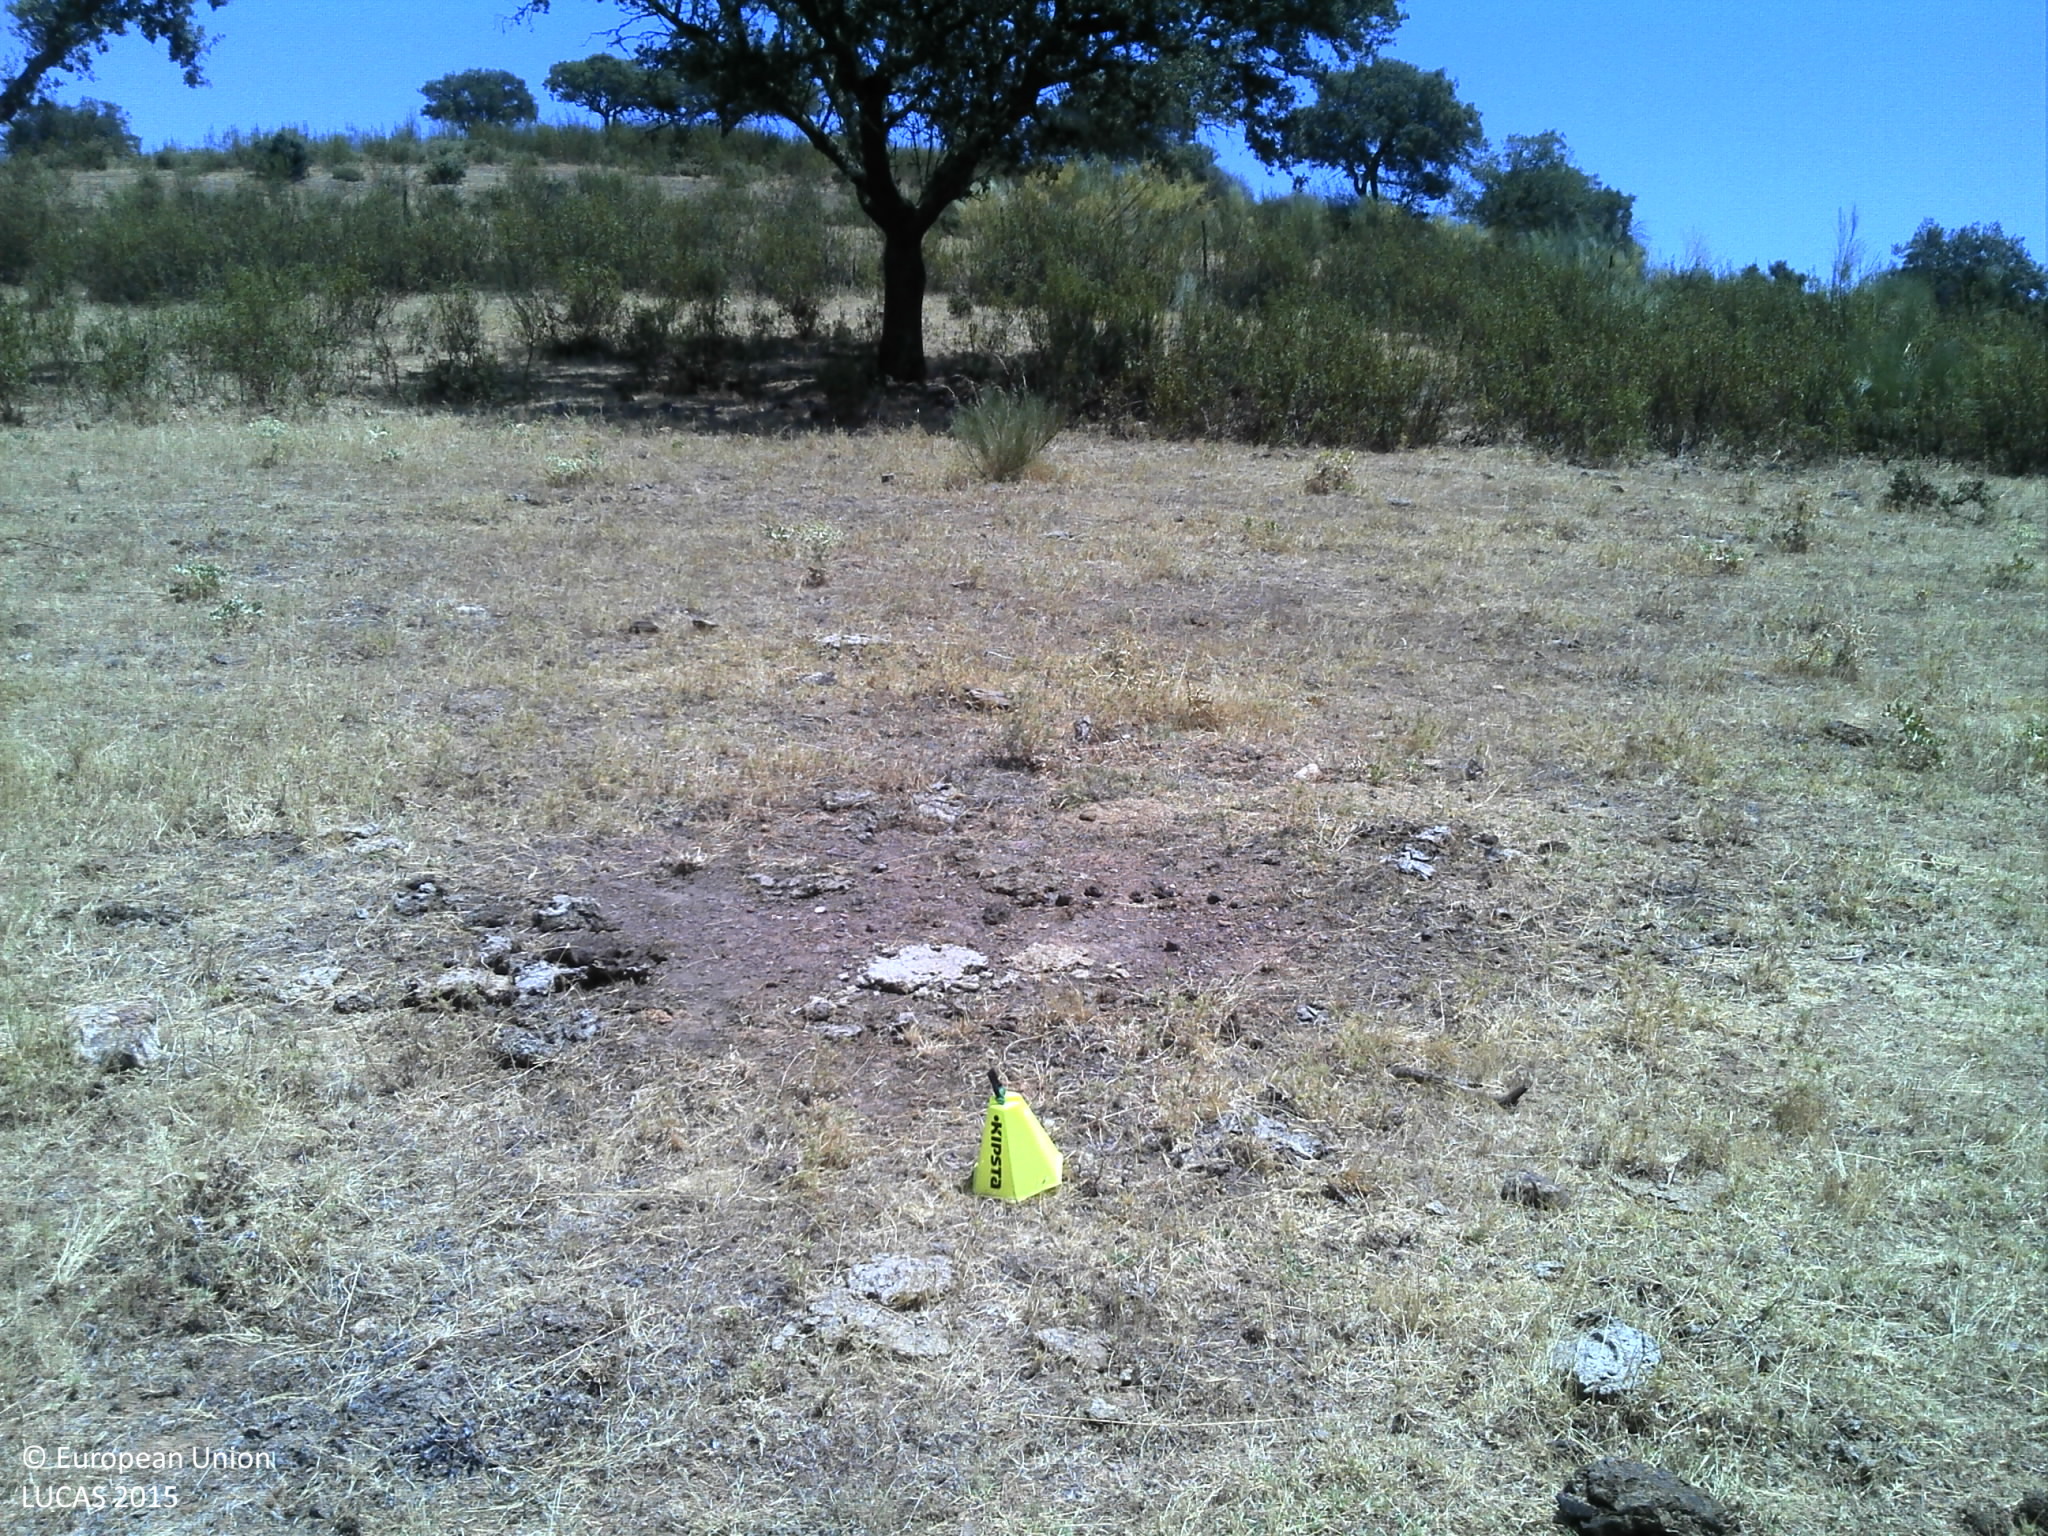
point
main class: Woodland
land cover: Broadleaved woodland
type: broadleaved evergreen forest
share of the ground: 10 - 25 %
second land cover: Grassland without tree/shrub cover
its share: 10 - 25 %
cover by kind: unconsolidated bare surface 70 %, broadleaved forest trees 15 %, herbaceous plants 15 %
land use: Forestry
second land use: Agriculture (excluding fallow land and kitchen gardens)
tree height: > 5 m
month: July
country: PT
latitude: 38.6631
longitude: -7.3941
